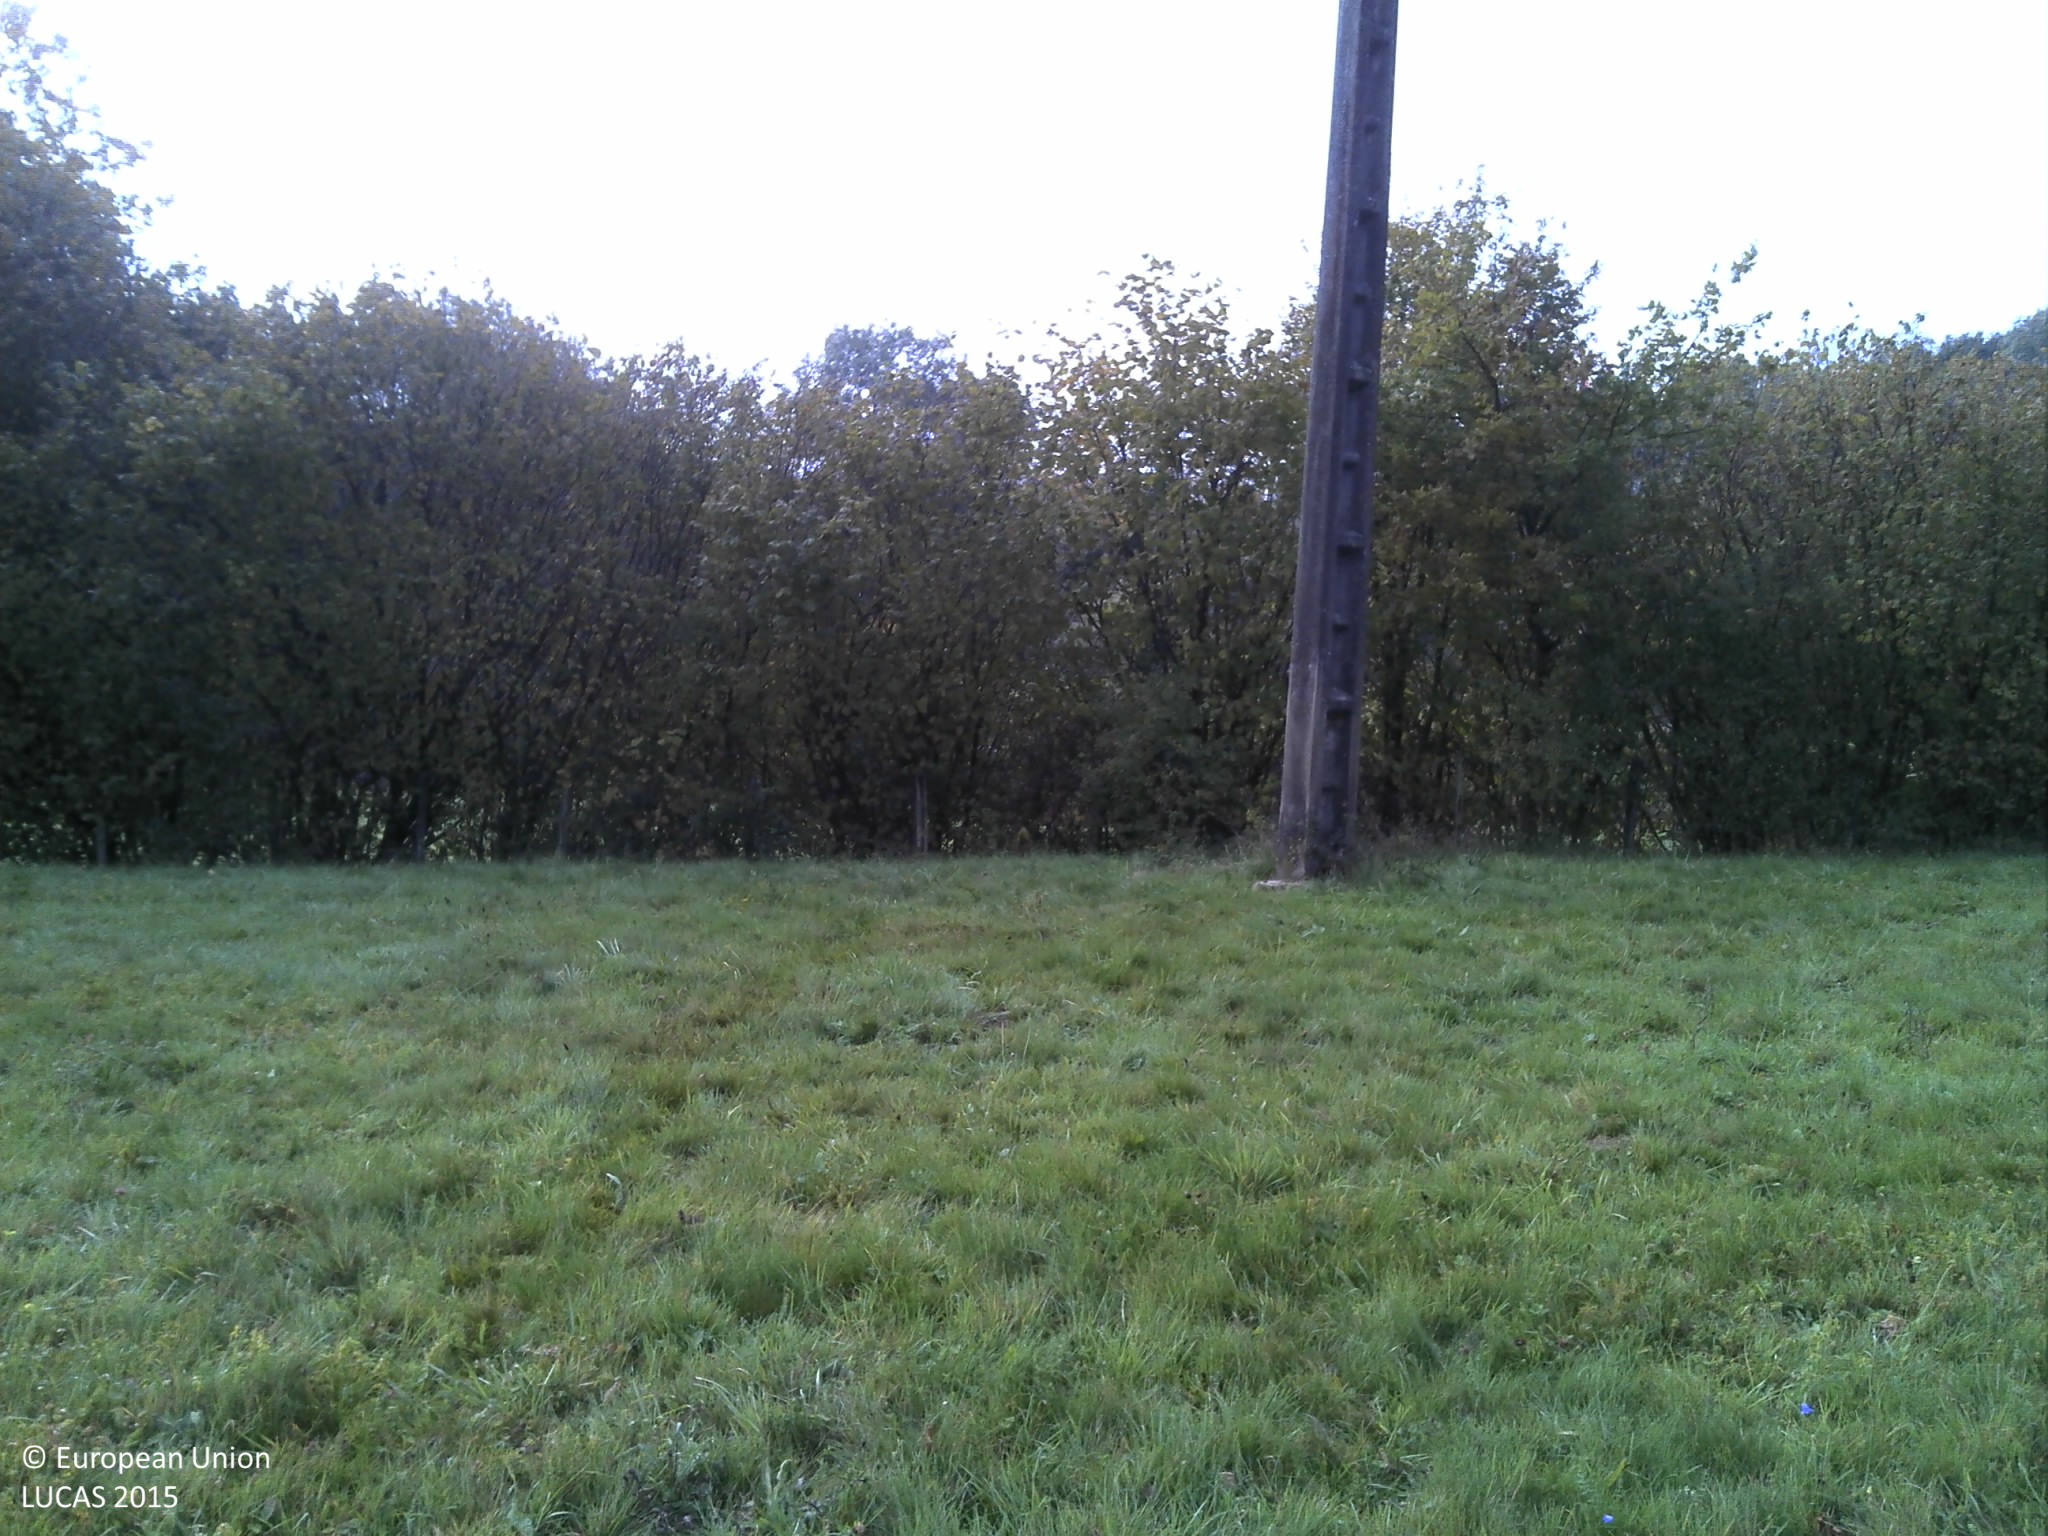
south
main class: Grassland
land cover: Grassland without tree/shrub cover
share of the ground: > 75 %
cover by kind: herbaceous plants 100 %
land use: Agriculture (excluding fallow land and kitchen gardens)
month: October
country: FR
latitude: 46.1073
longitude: 5.3846
